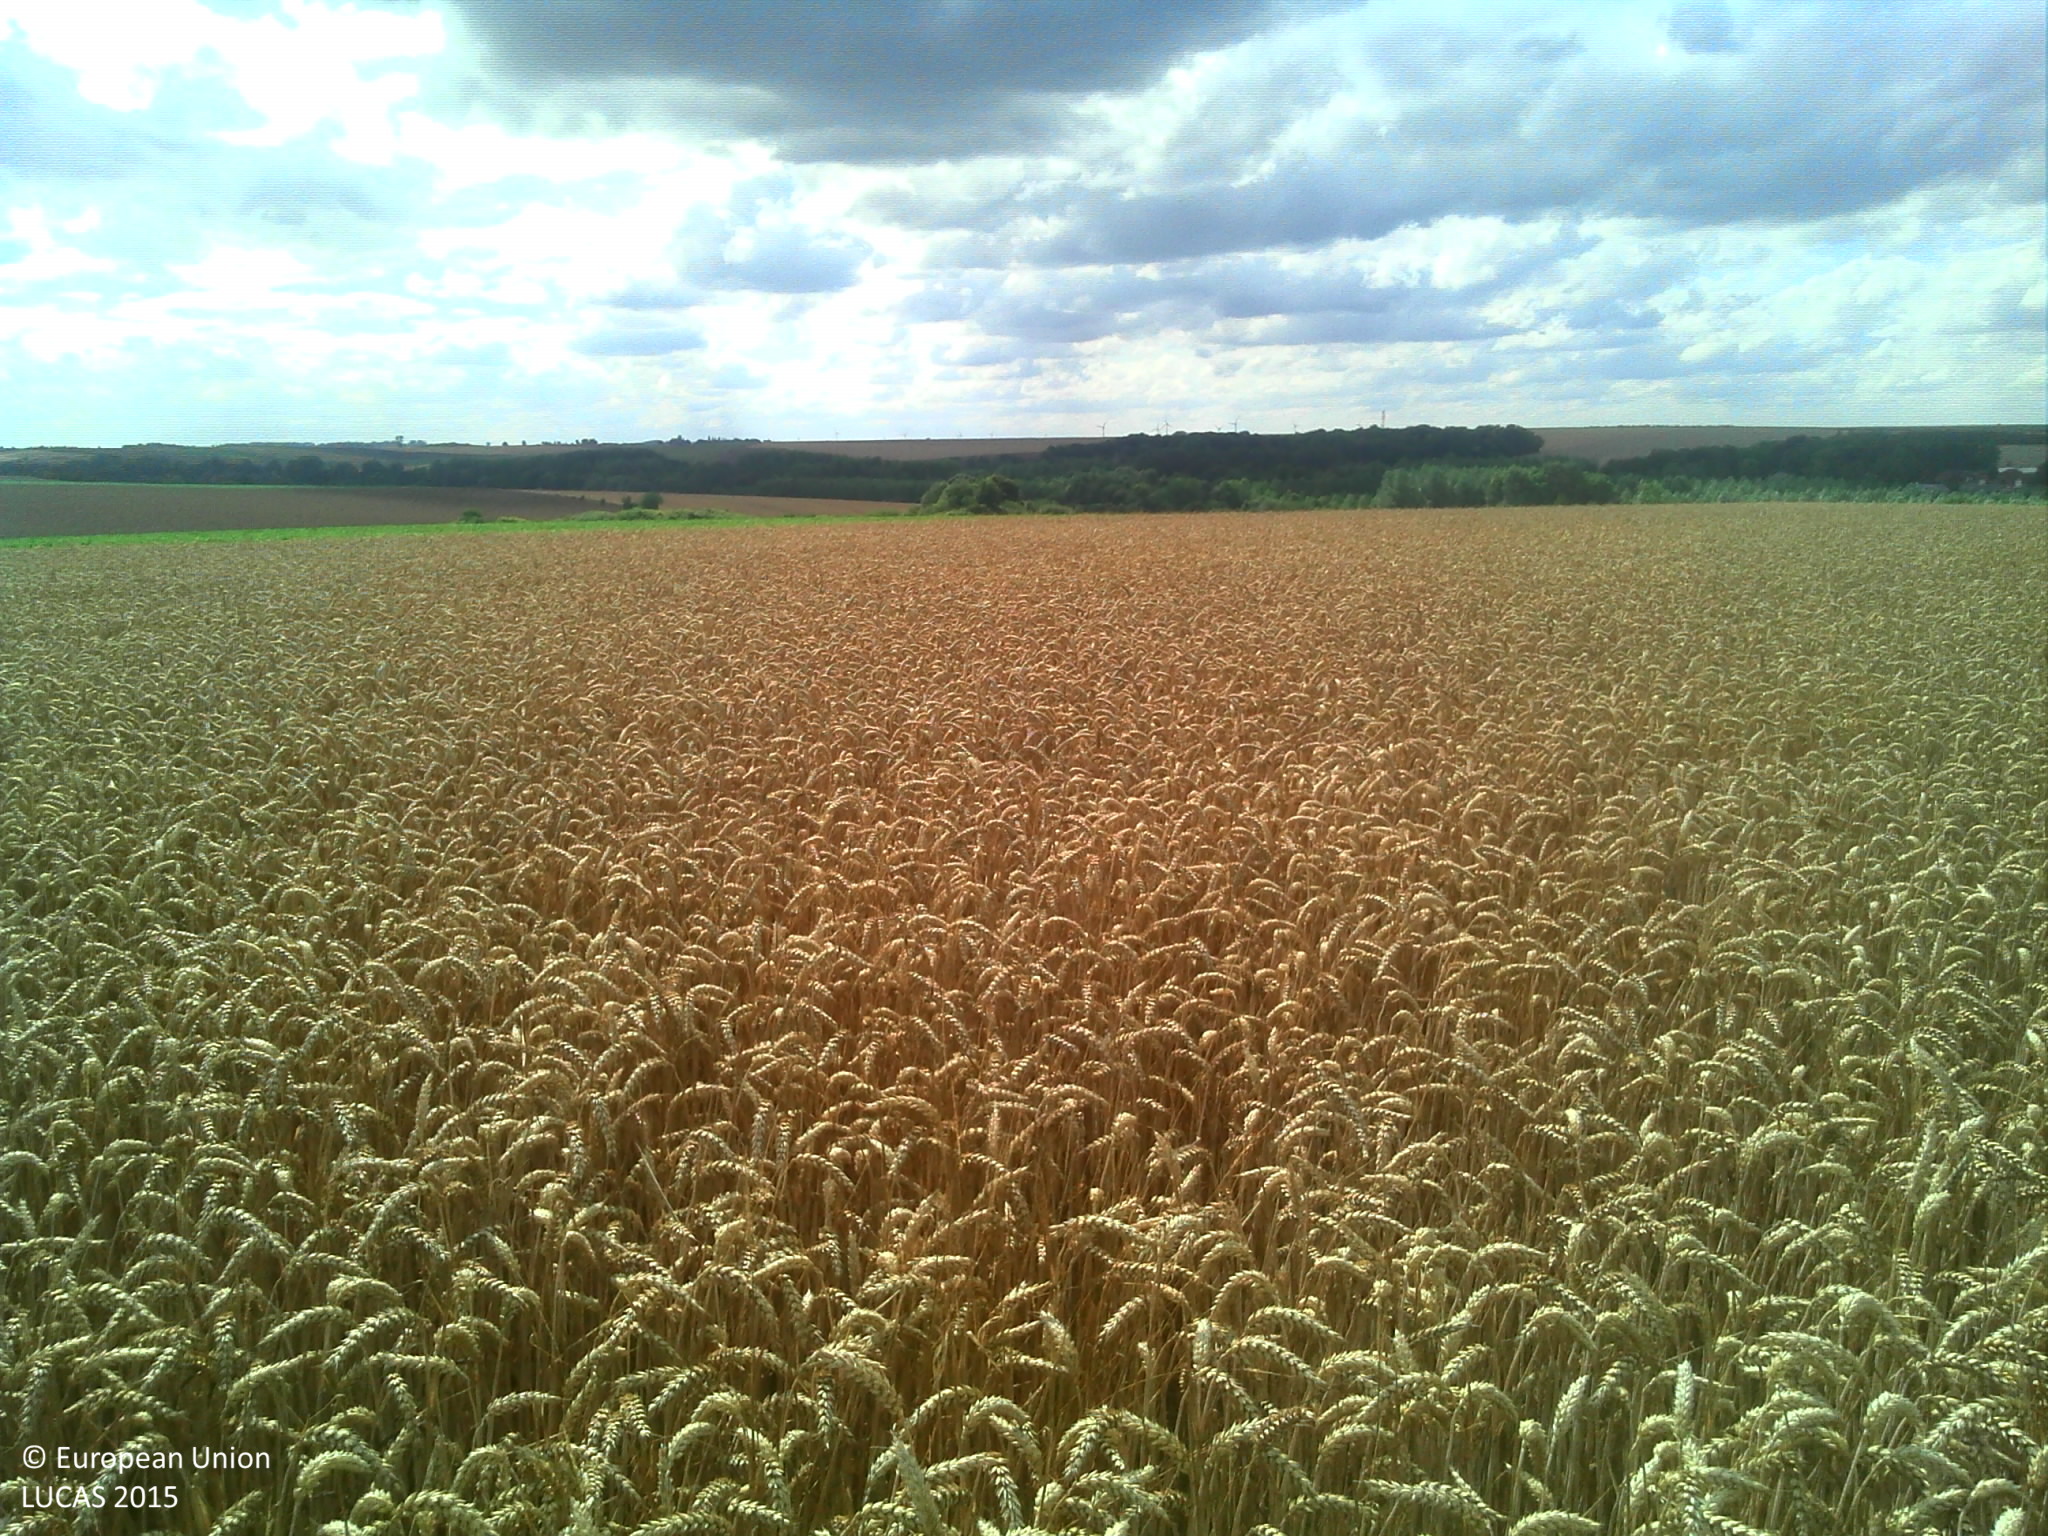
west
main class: Cropland
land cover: Common wheat
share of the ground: > 75 %
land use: Agriculture (excluding fallow land and kitchen gardens)
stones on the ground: < 10 %
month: July
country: FR
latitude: 49.7516
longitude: 3.5946
